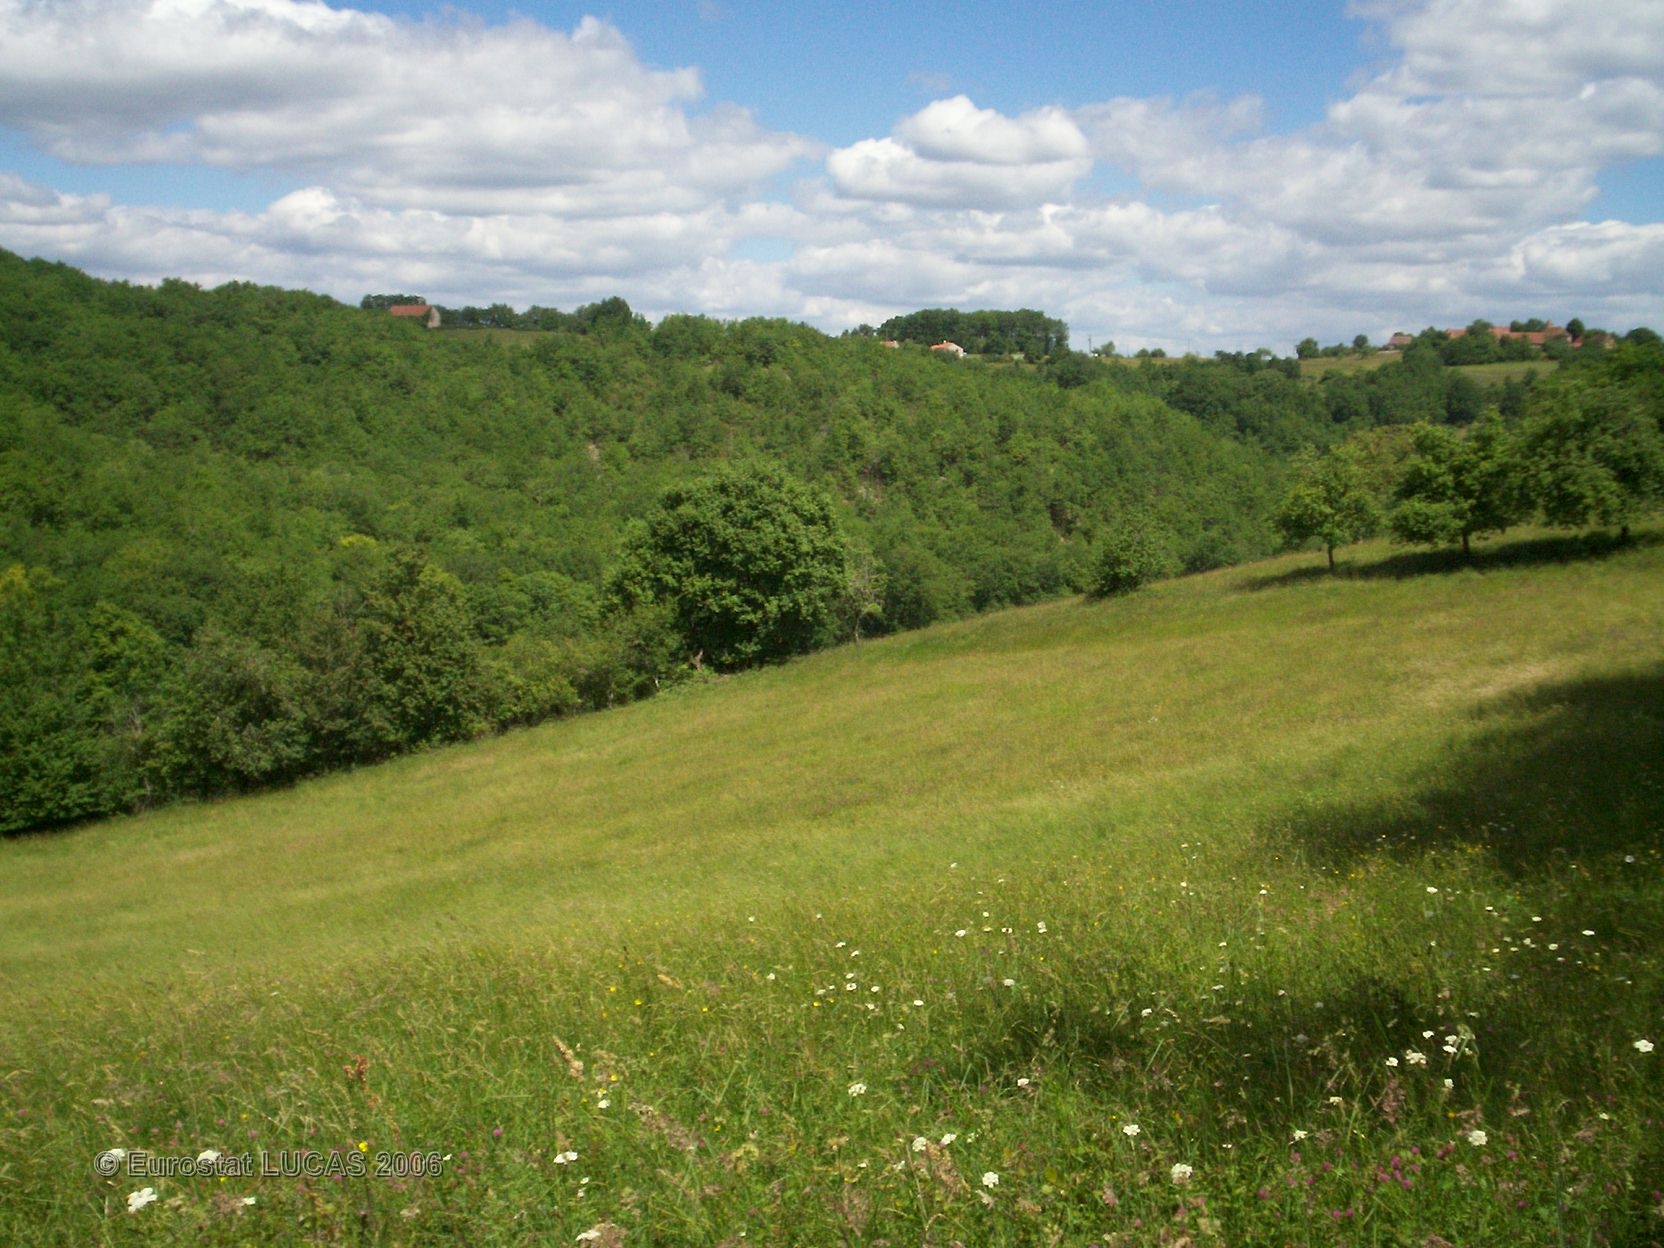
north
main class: Grassland
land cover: Grassland without tree/shrub cover
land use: Agriculture (excluding fallow land and kitchen gardens)
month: May
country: FR
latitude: 44.6265
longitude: 1.3883
